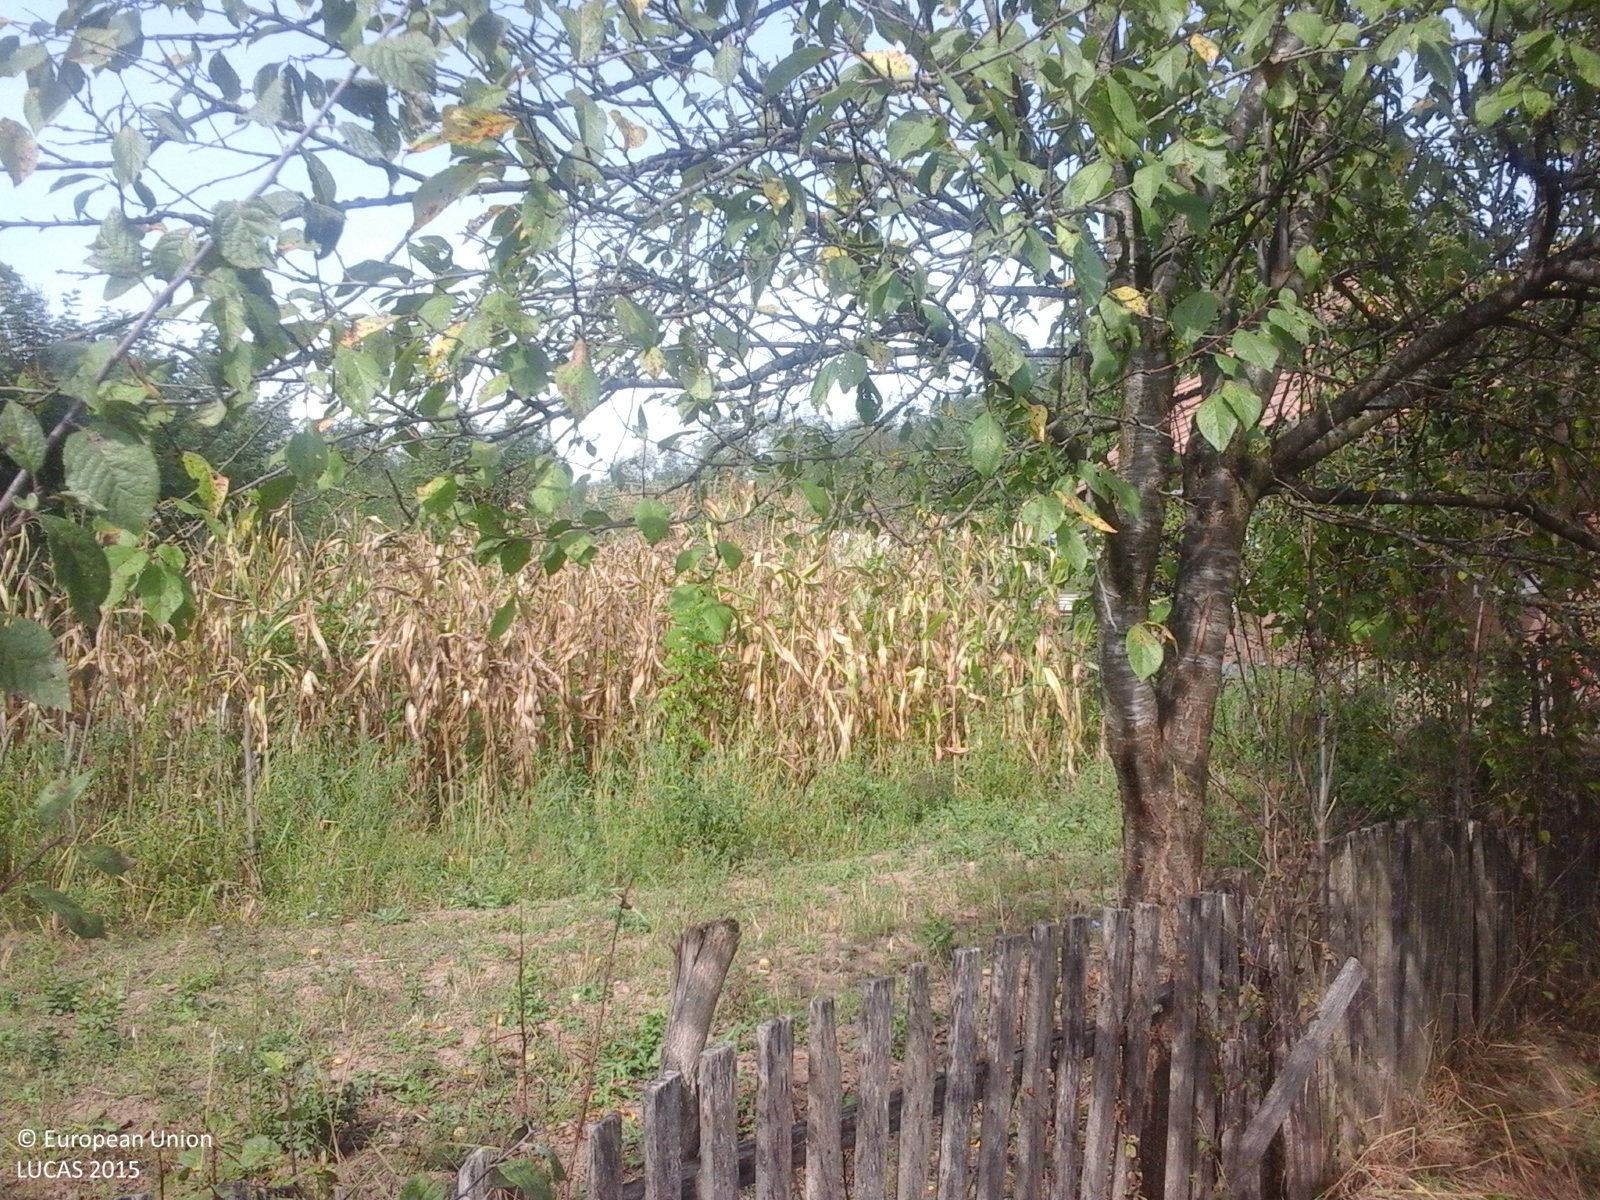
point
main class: Cropland
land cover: Maize
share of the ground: > 75 %
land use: Kitchen garden
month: September
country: RO
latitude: 47.1052
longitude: 23.2842
